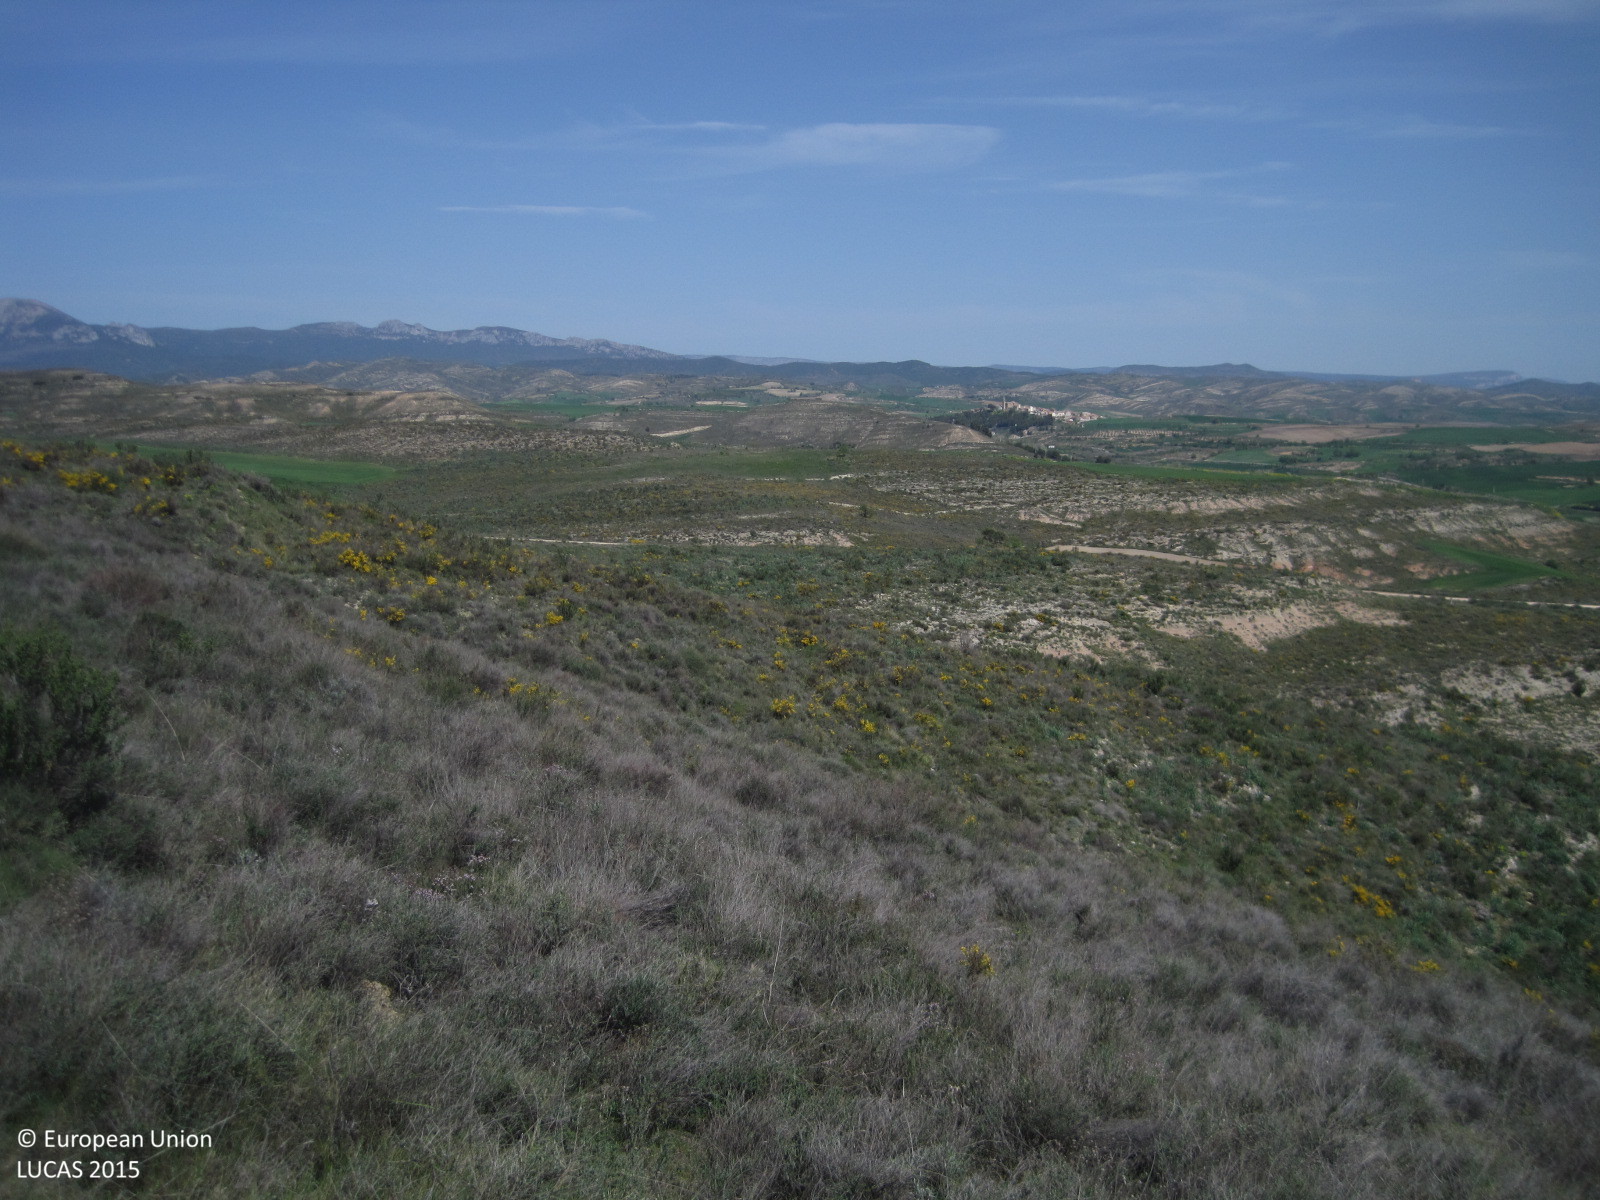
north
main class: Shrubland
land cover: Shrubland without tree cover
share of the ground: > 75 %
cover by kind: shrubs 60 %, herbaceous plants 40 %
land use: Semi-natural and natural areas not in use
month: April
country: ES
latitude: 42.5244
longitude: -2.2775
